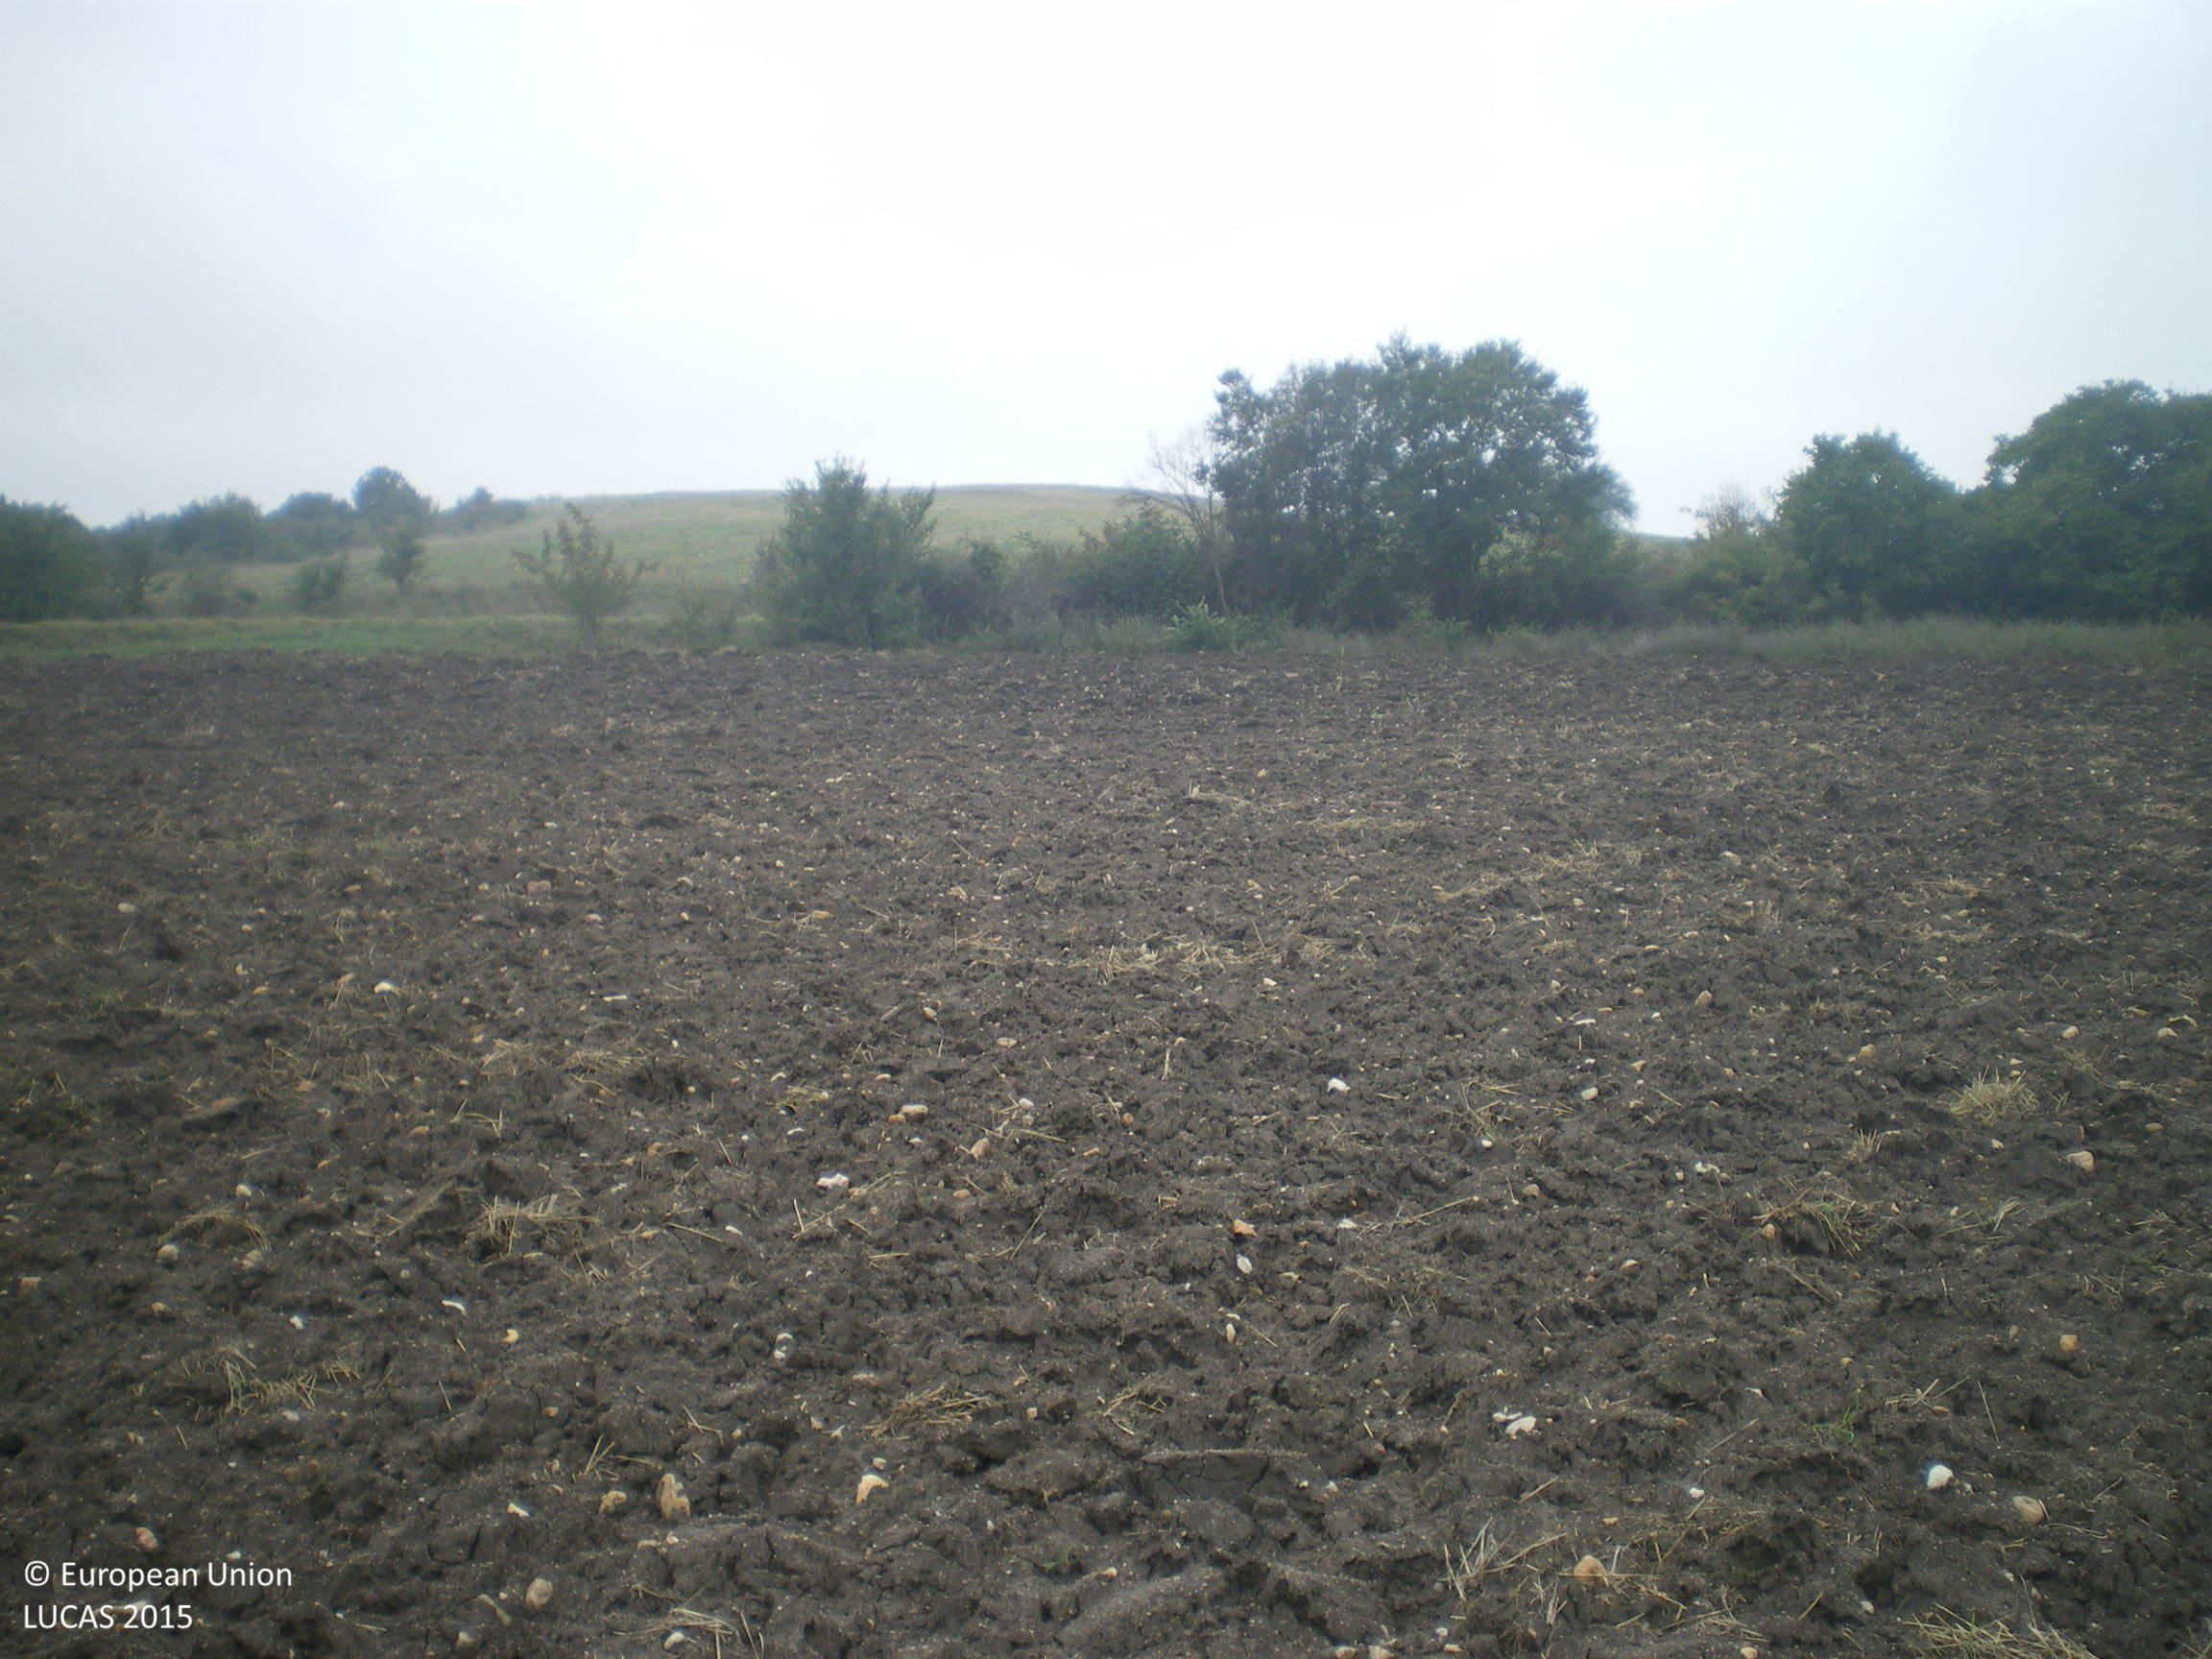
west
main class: Cropland
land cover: Common wheat
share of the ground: < 10 %
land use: Agriculture (excluding fallow land and kitchen gardens)
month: October
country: BG
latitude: 41.8184
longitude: 26.1960
